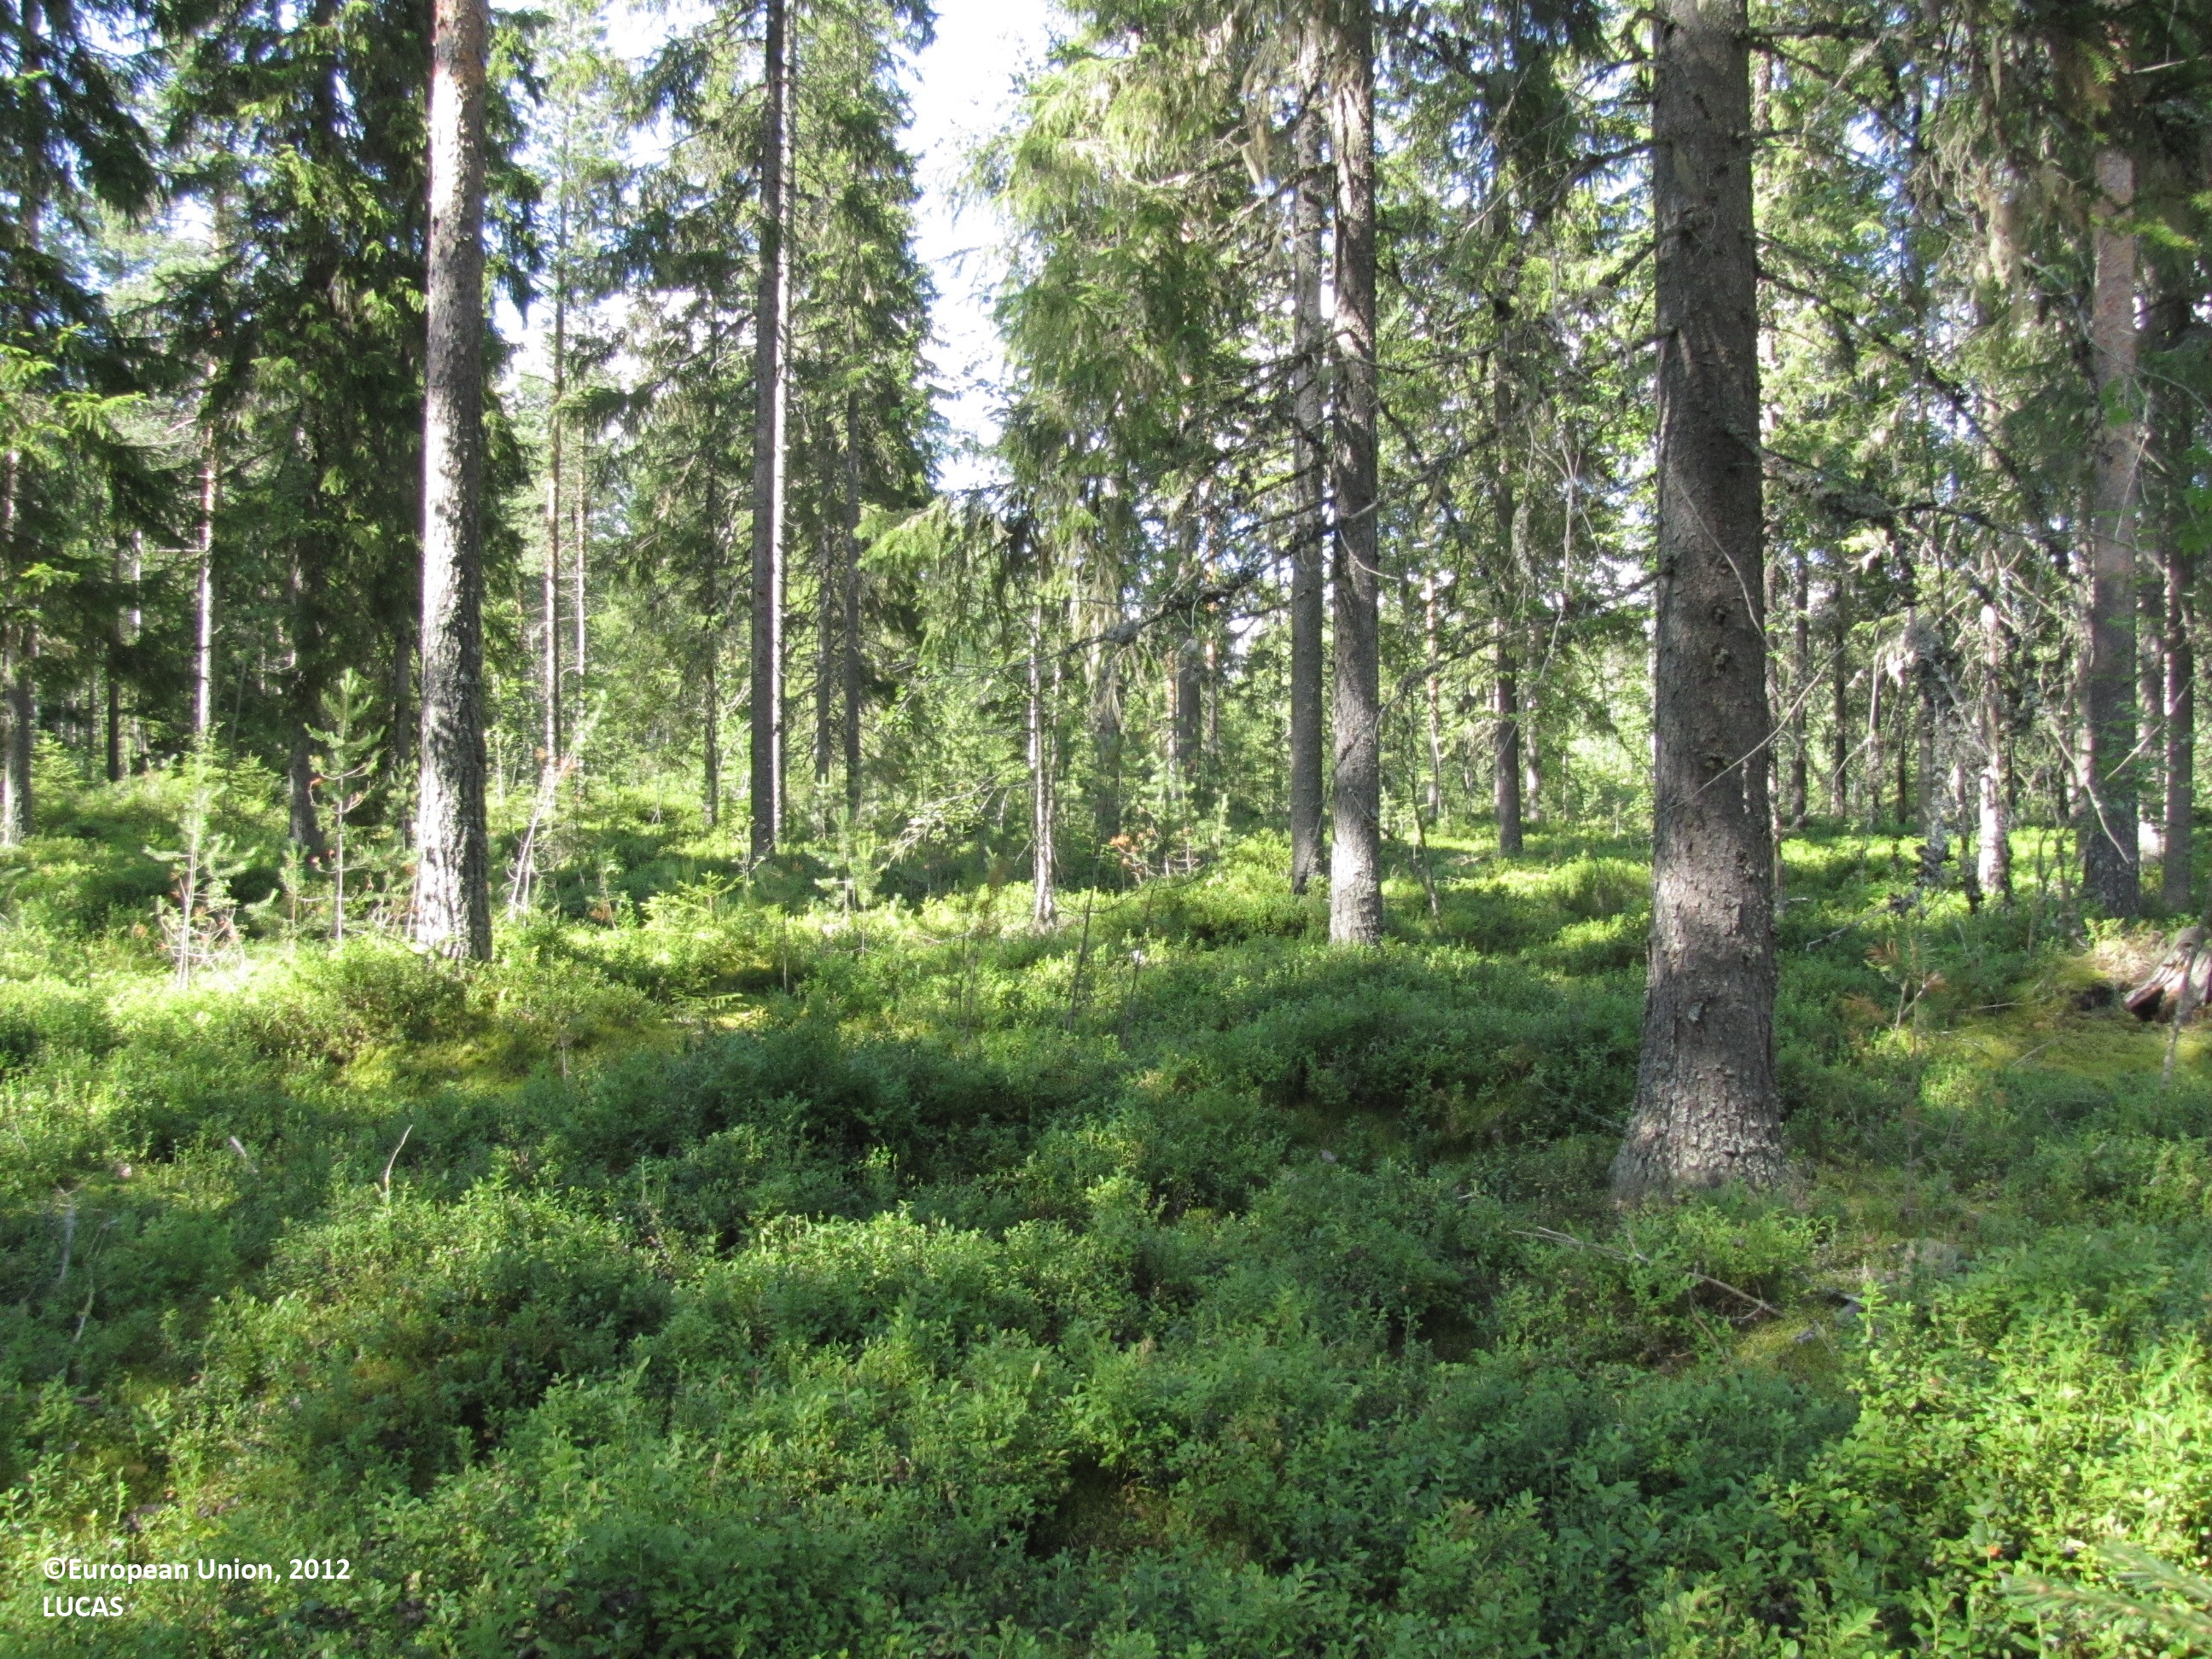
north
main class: Woodland
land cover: Spruce dominated coniferous woodland
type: boreal forest
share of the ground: 50 - 75 %
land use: Forestry
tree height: > 5 m
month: July
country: FI
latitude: 62.1868
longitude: 23.2682
